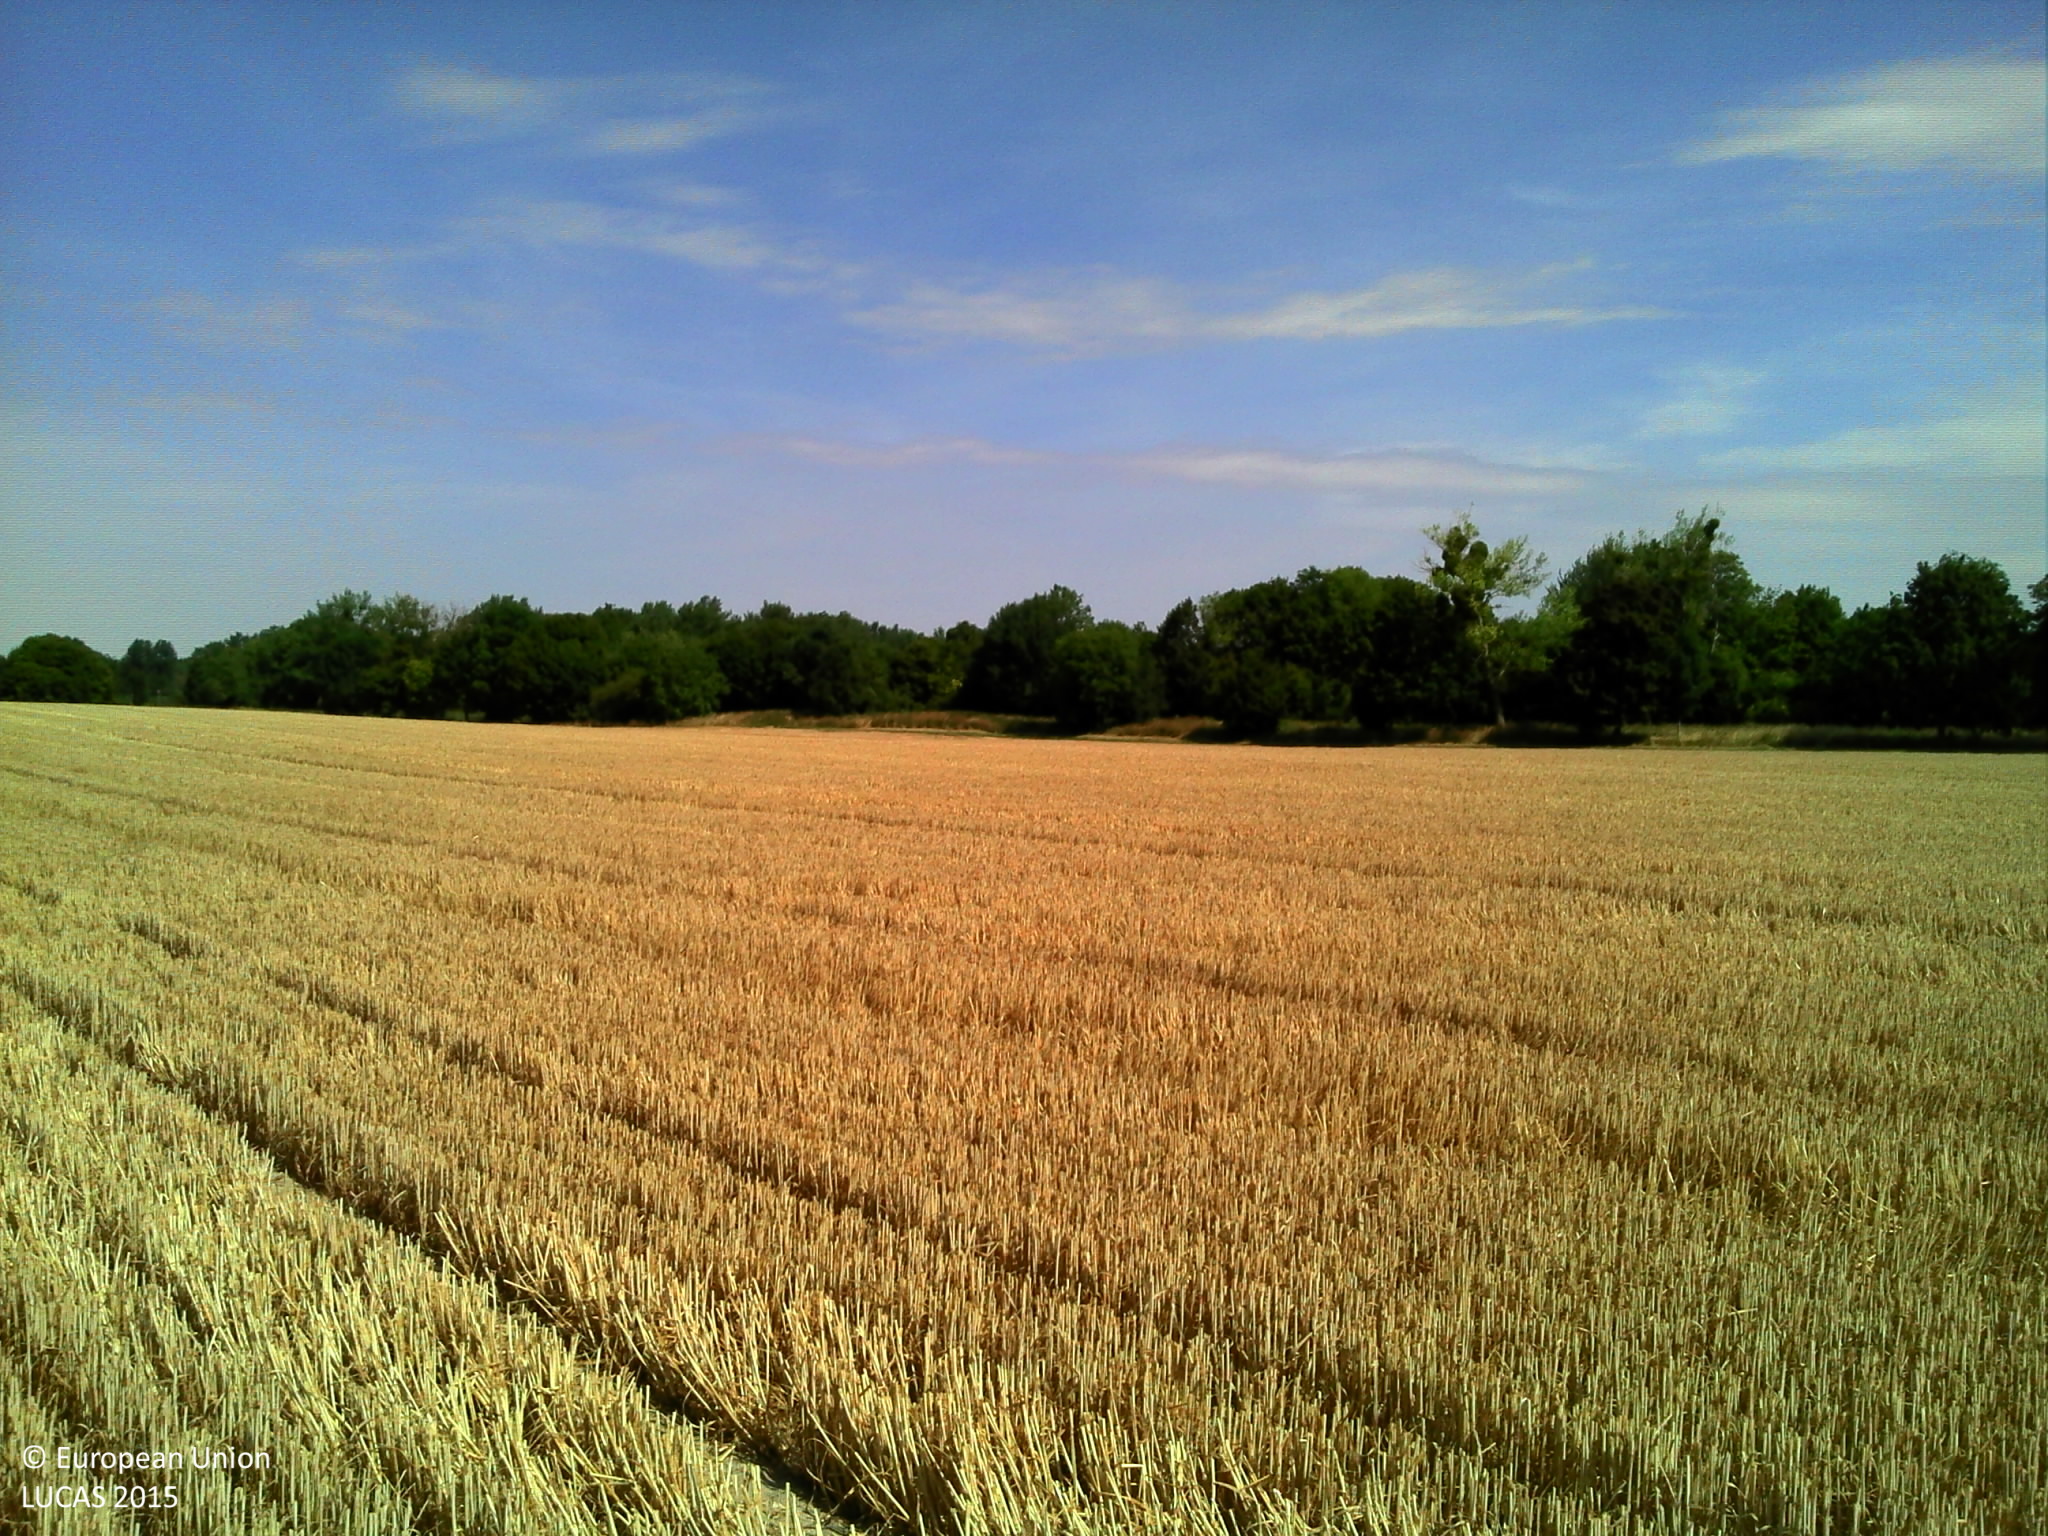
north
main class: Cropland
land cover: Common wheat
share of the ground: > 75 %
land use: Agriculture (excluding fallow land and kitchen gardens)
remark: Harvested field
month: August
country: FR
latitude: 49.1708
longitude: 4.1938
